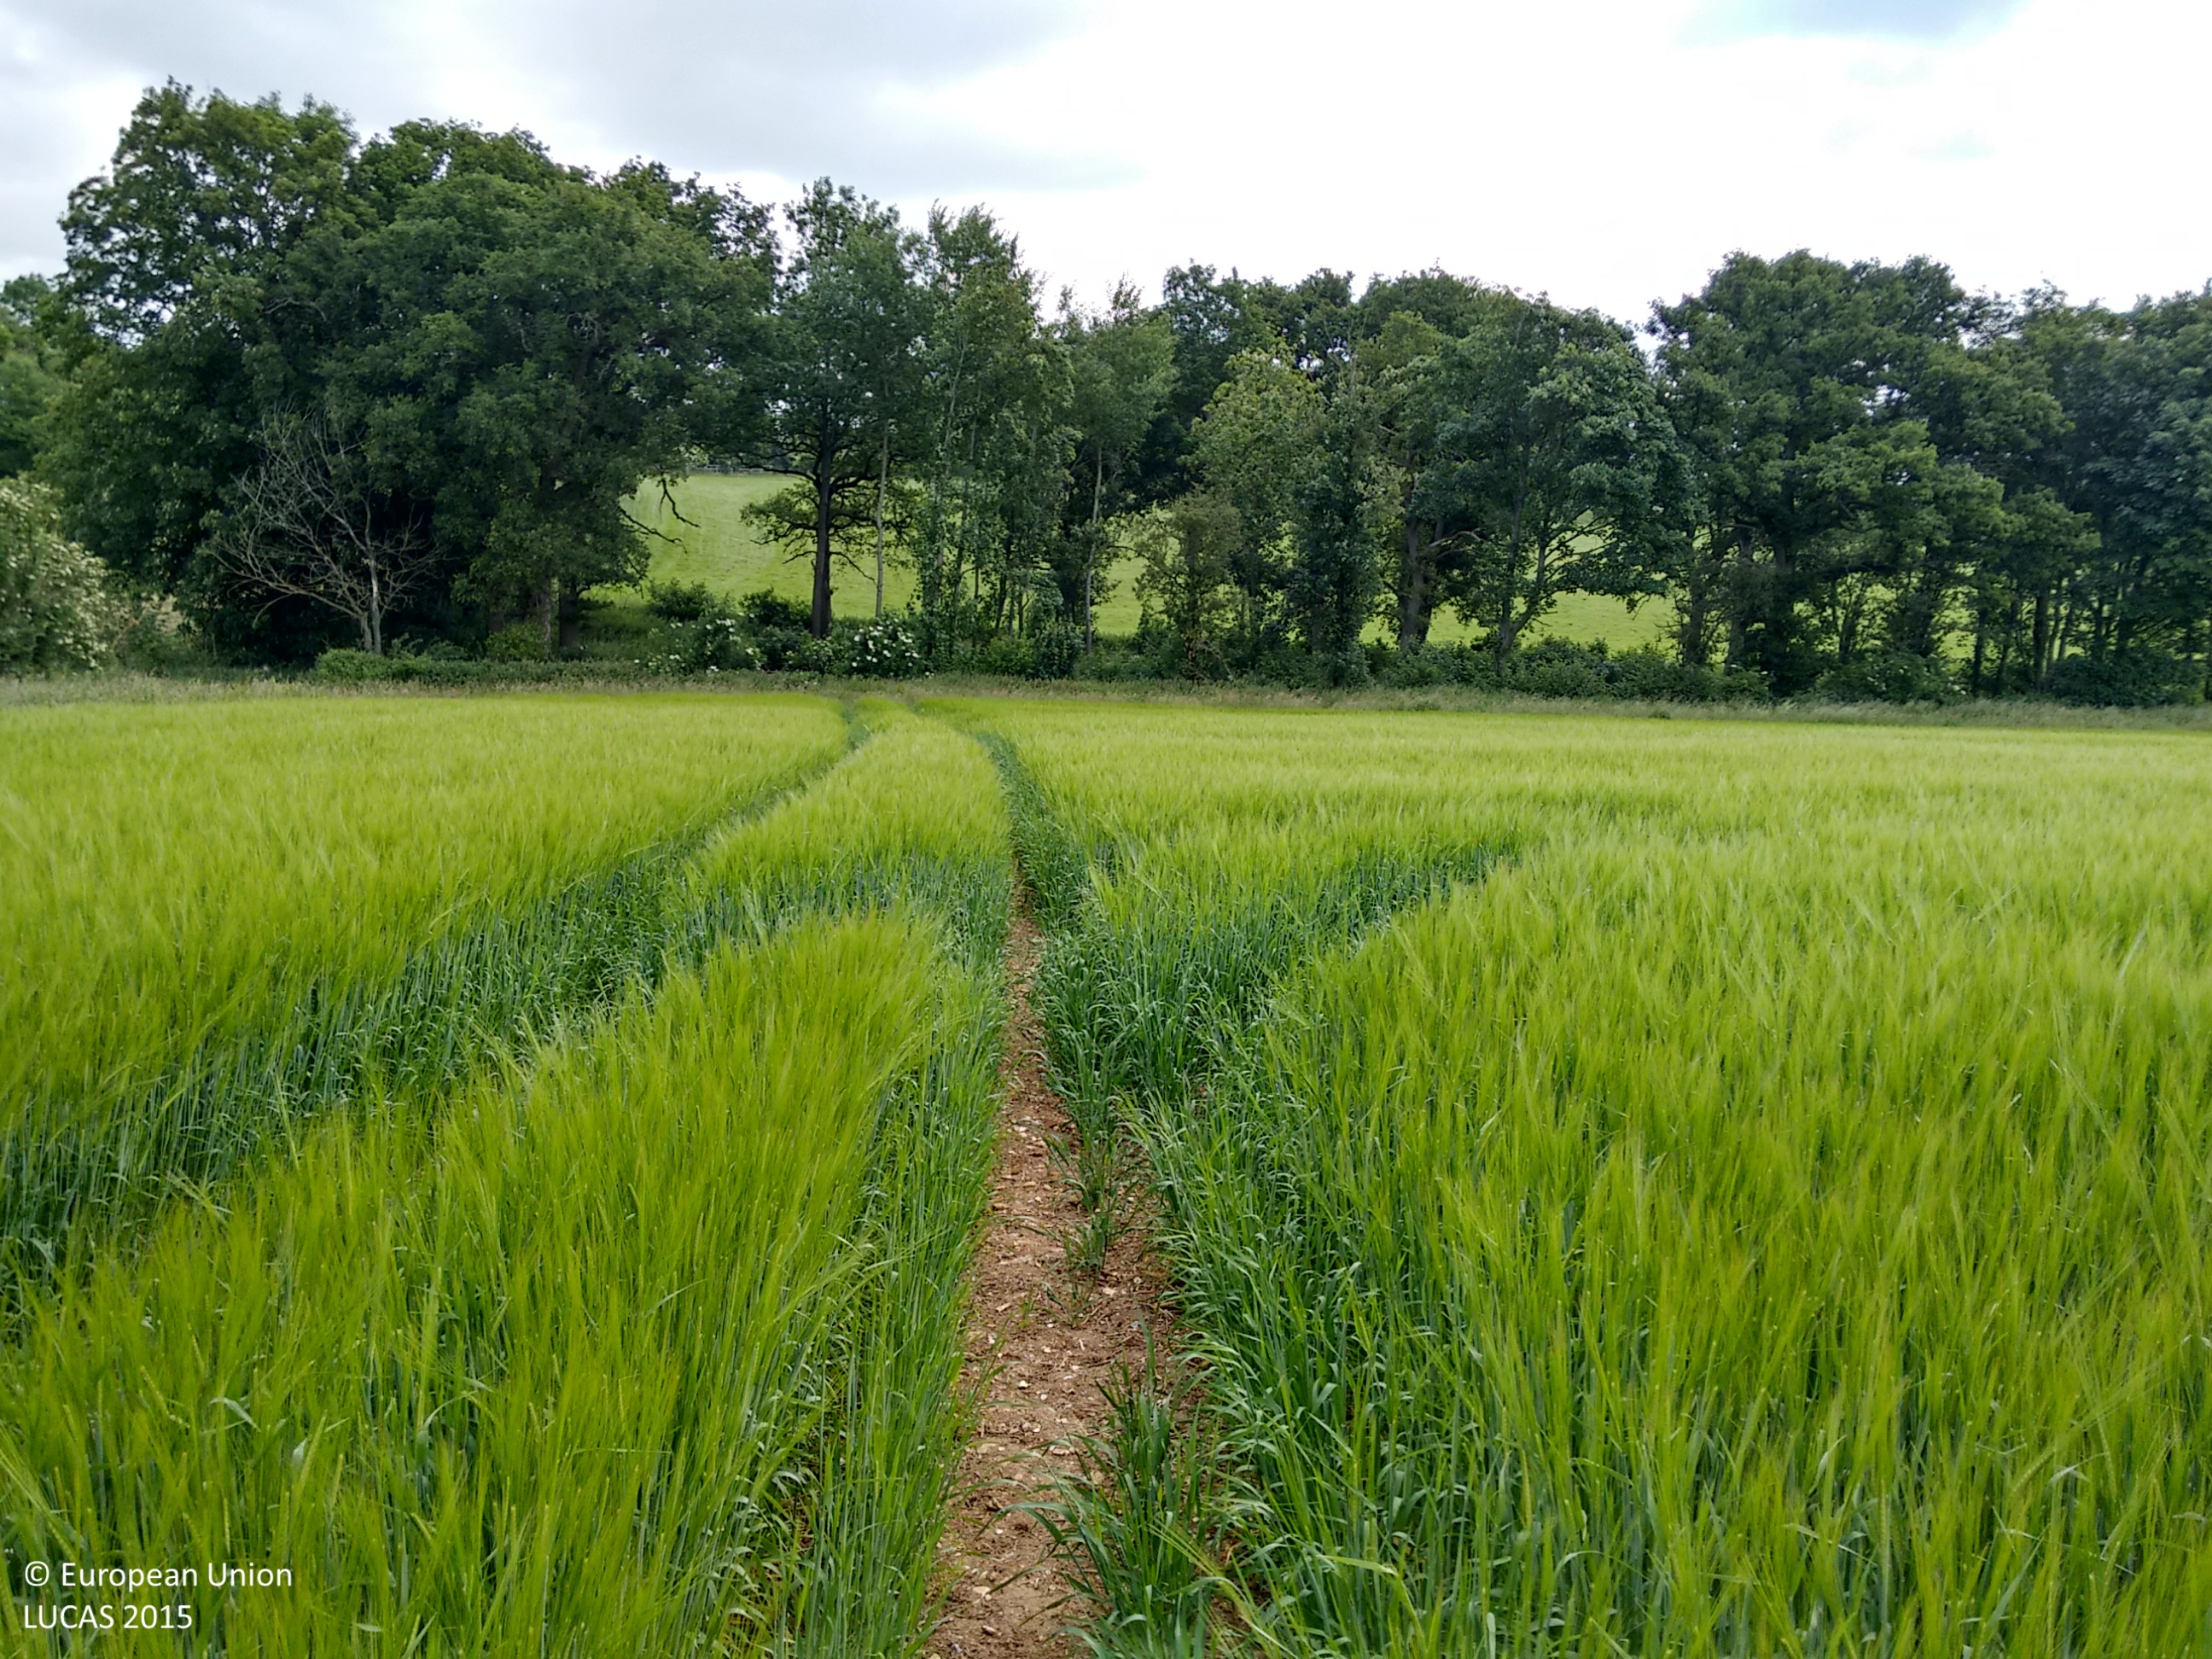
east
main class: Cropland
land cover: Barley
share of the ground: > 75 %
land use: Agriculture (excluding fallow land and kitchen gardens)
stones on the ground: 25 - 50 %
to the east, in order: Barley; Grassland without tree/shrub cover; Broadleaved woodland; Tracks; Broadleaved woodland; Fences; Grassland without tree/shrub cover; Single bushes/trees; Grassland without tree/shrub cover; Single bushes/trees; Fences; Managed hedges; Grassland without tree/shrub cover
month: June
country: GB
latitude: 51.4539
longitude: -1.4919
